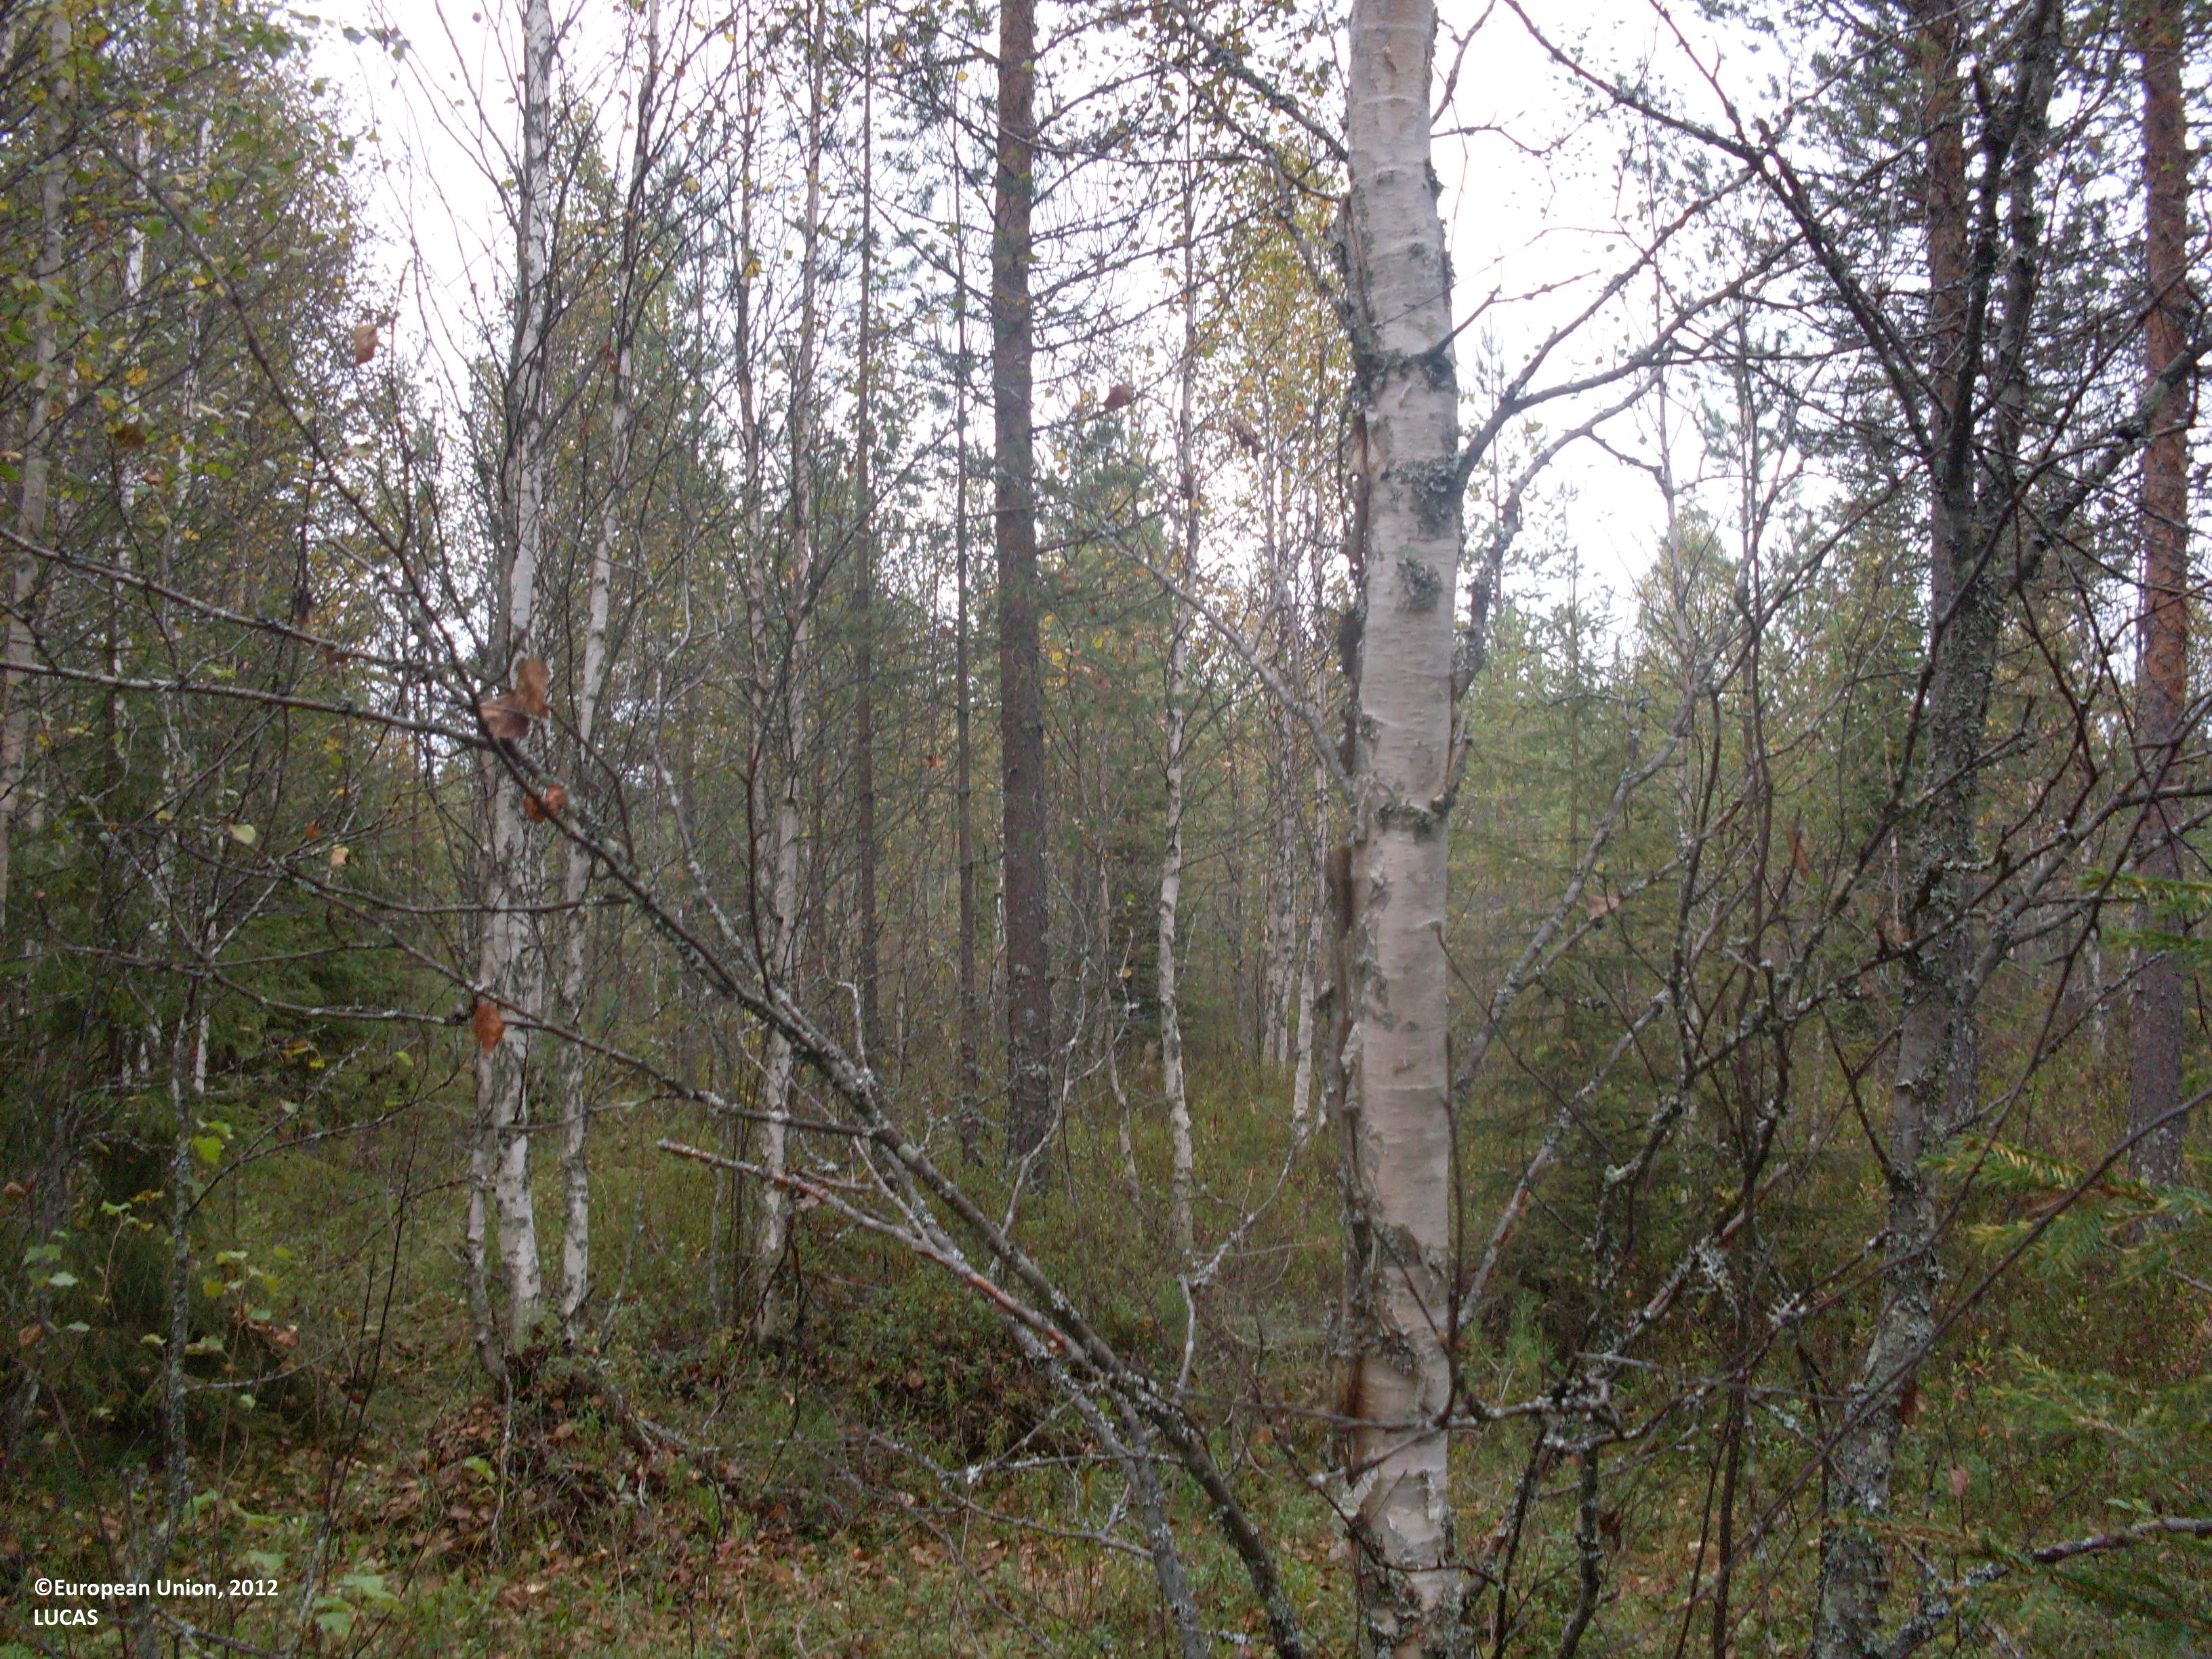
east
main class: Woodland
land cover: Other mixed woodland
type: boreal forest
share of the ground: 50 - 75 %
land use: Forestry
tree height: > 5 m
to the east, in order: Other mixed woodland; Ditches and canals; Pine dominated mixed woodland; Ditches and canals; Pine dominated mixed woodland; Ditches and canals; Pine dominated mixed woodland
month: September
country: FI
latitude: 63.9750
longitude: 29.7814
